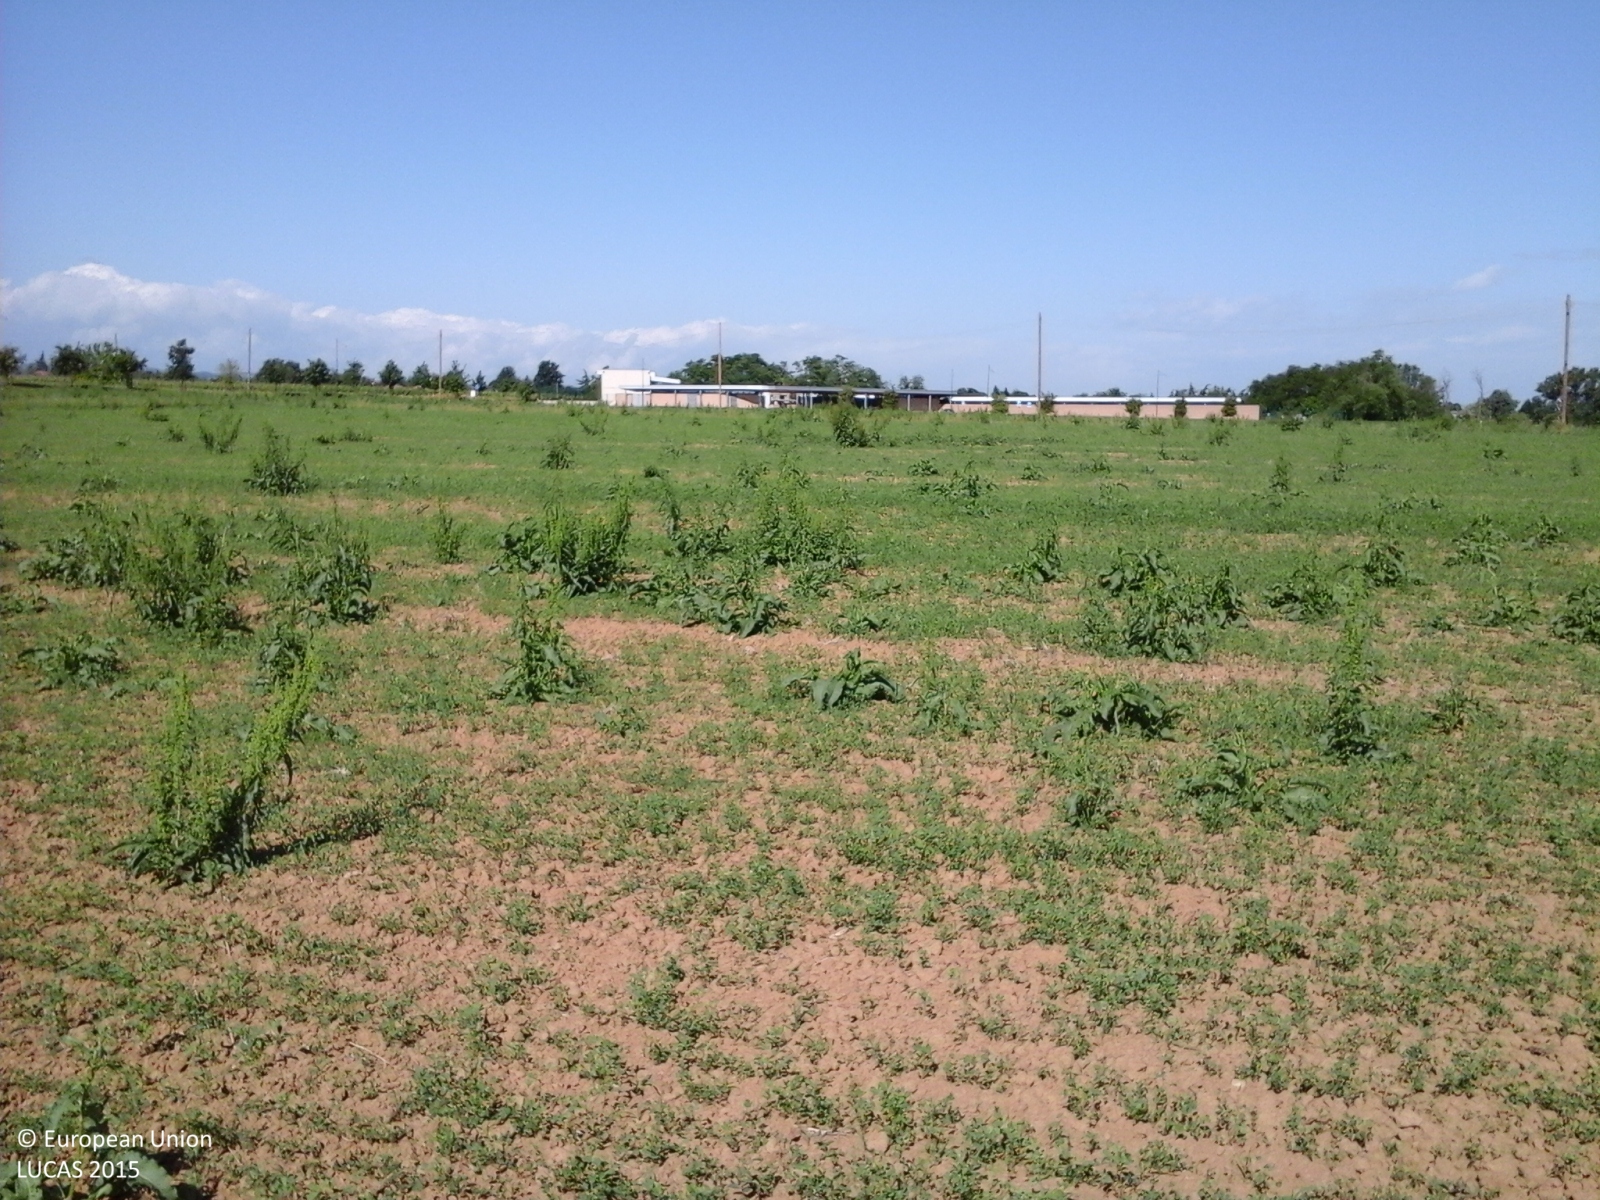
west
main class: Cropland
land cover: Lucerne
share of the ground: 50 - 75 %
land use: Agriculture (excluding fallow land and kitchen gardens)
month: May
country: IT
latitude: 44.6373
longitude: 10.6164
